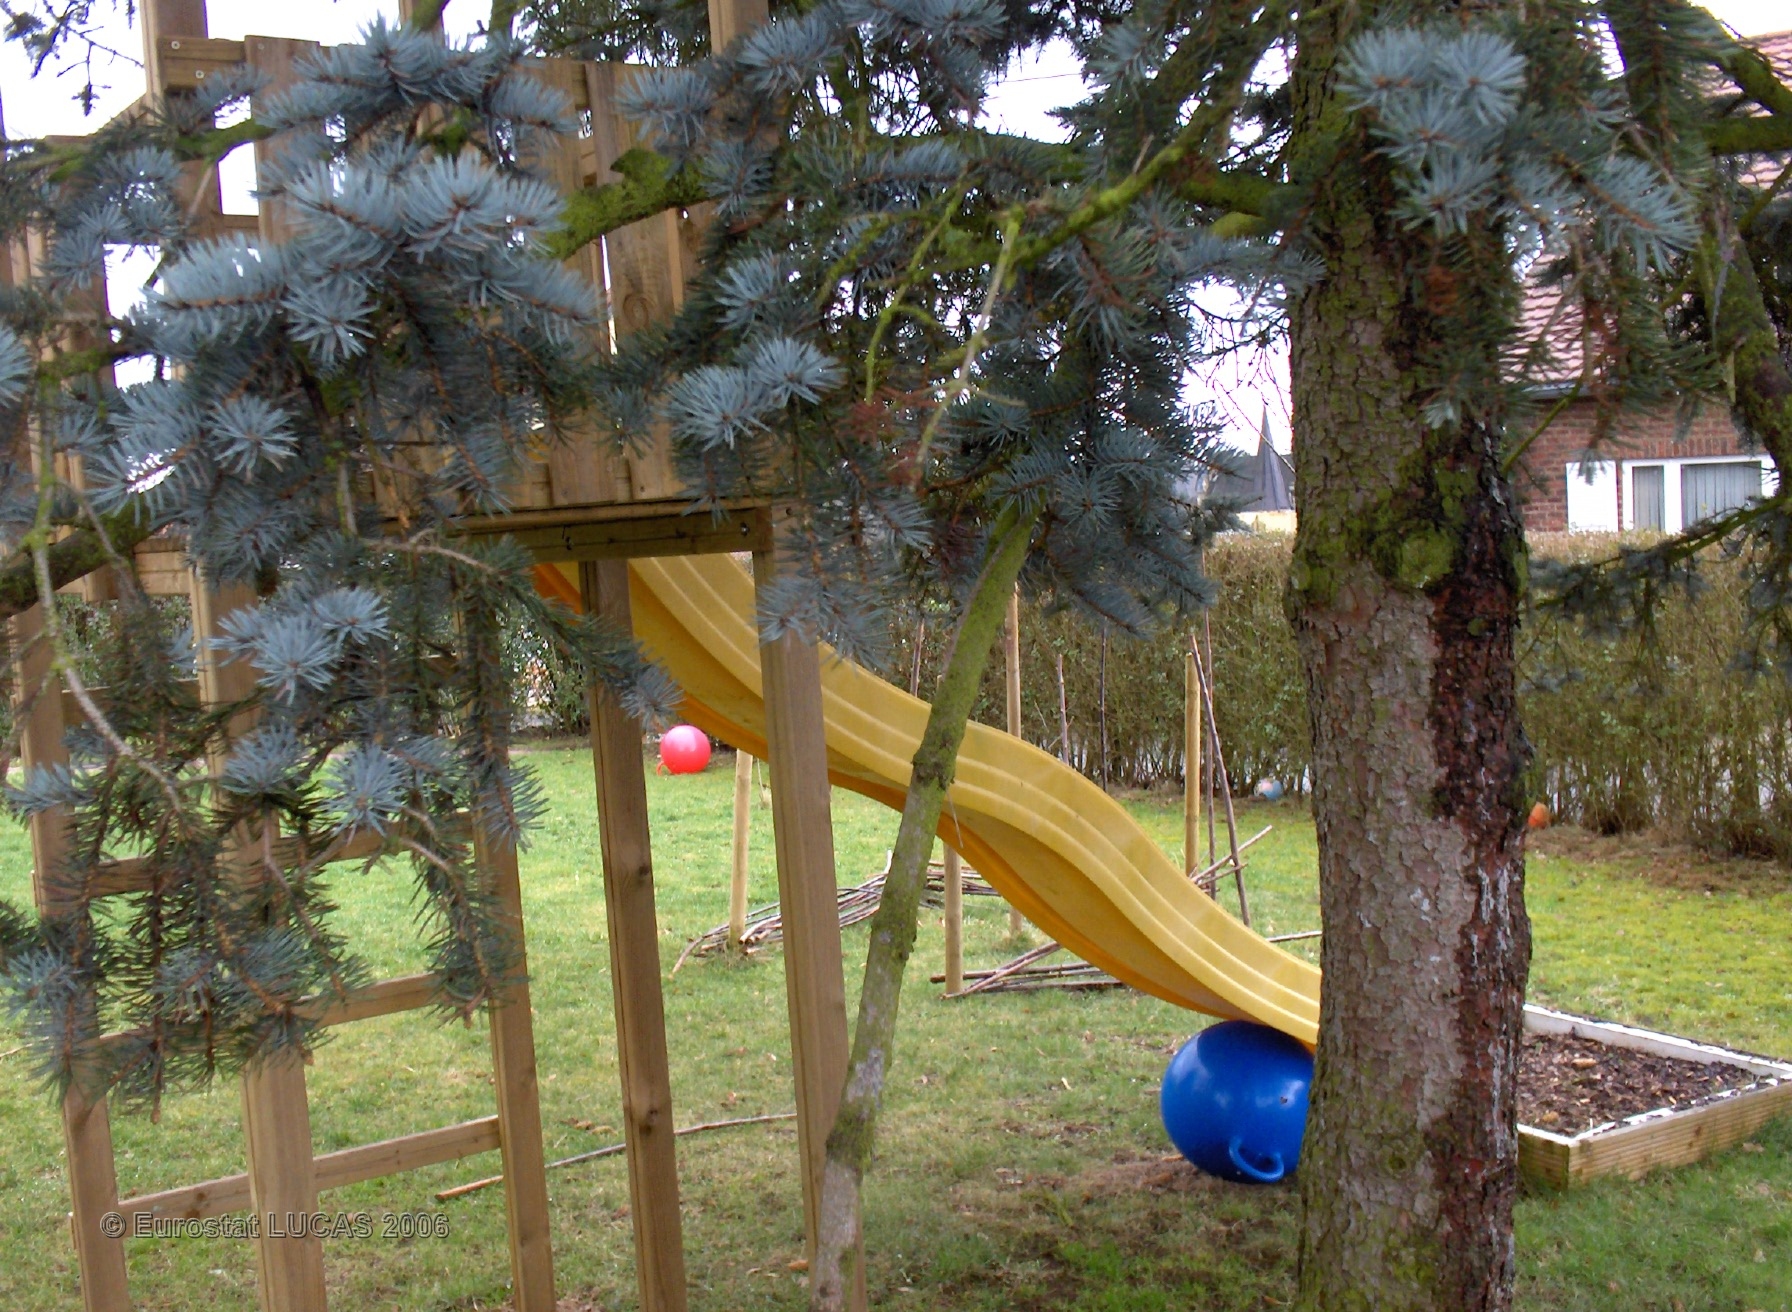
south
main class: Grassland
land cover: Grassland with sparse tree/shrub cover
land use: Residential
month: February
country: BE
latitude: 50.7742
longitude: 4.5363
